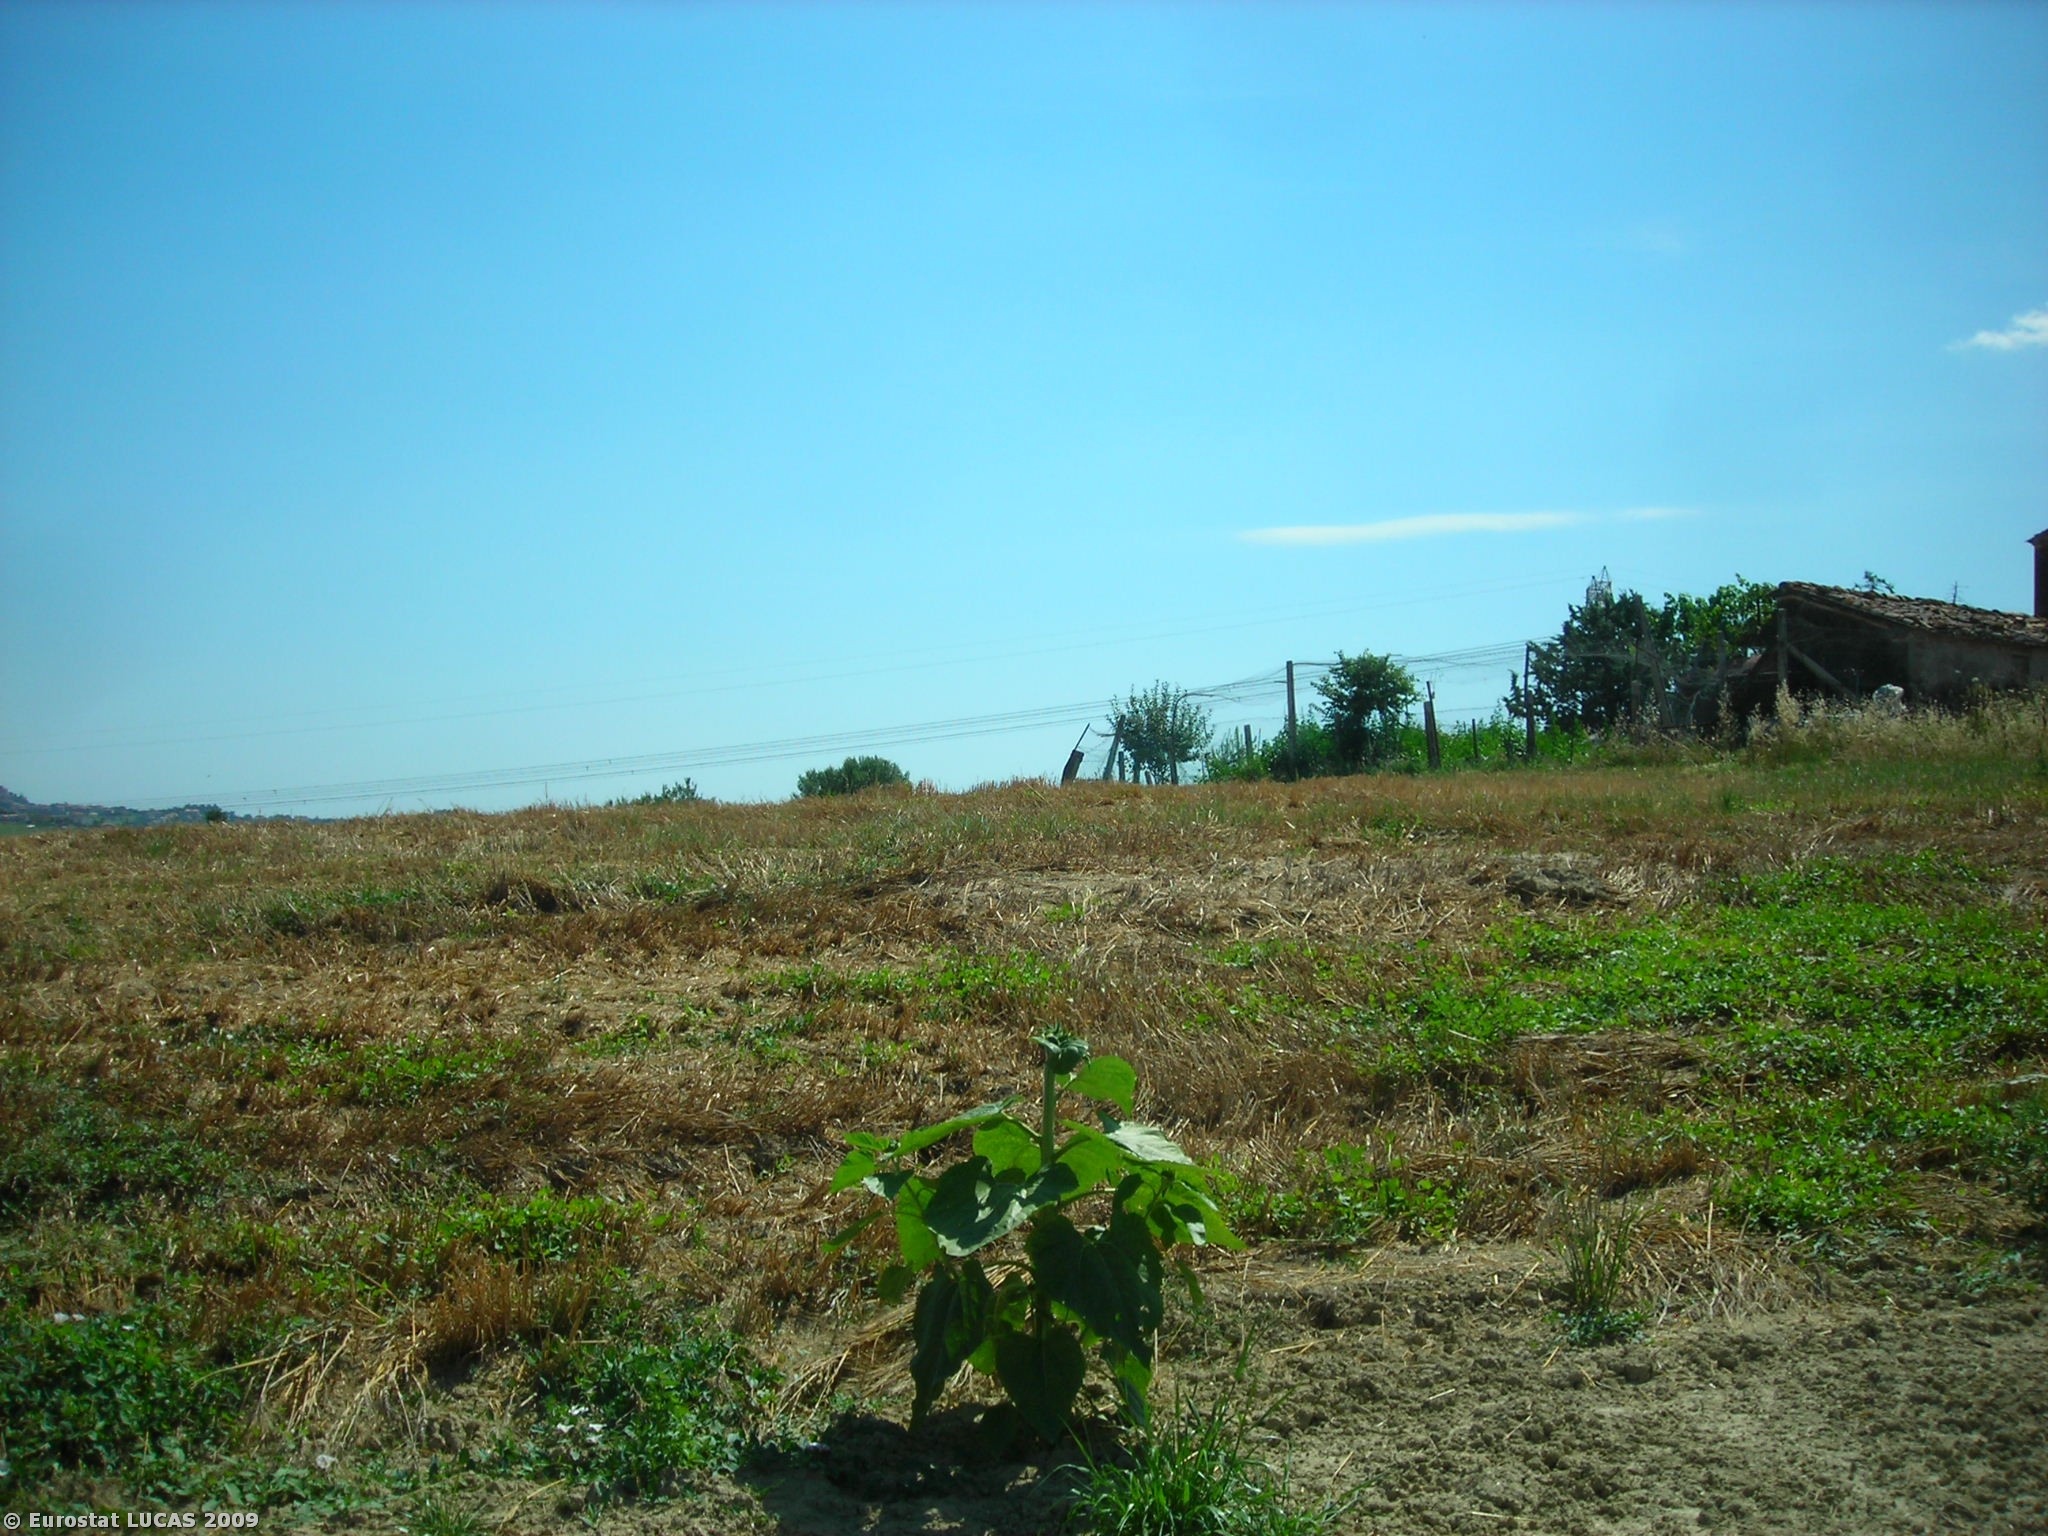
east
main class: Cropland
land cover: Sunflower
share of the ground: > 75 %
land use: Agriculture (excluding fallow land and kitchen gardens)
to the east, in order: Sunflower; Durum wheat; Grass margins; Durum wheat; Grass margins; Tracks; Grass margins; Lucerne; Durum wheat; Grass margins; Paved roads, cycling and walking lanes; Electric lines; Grass margins; Durum wheat
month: July
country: IT
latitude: 43.4137
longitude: 13.2891
